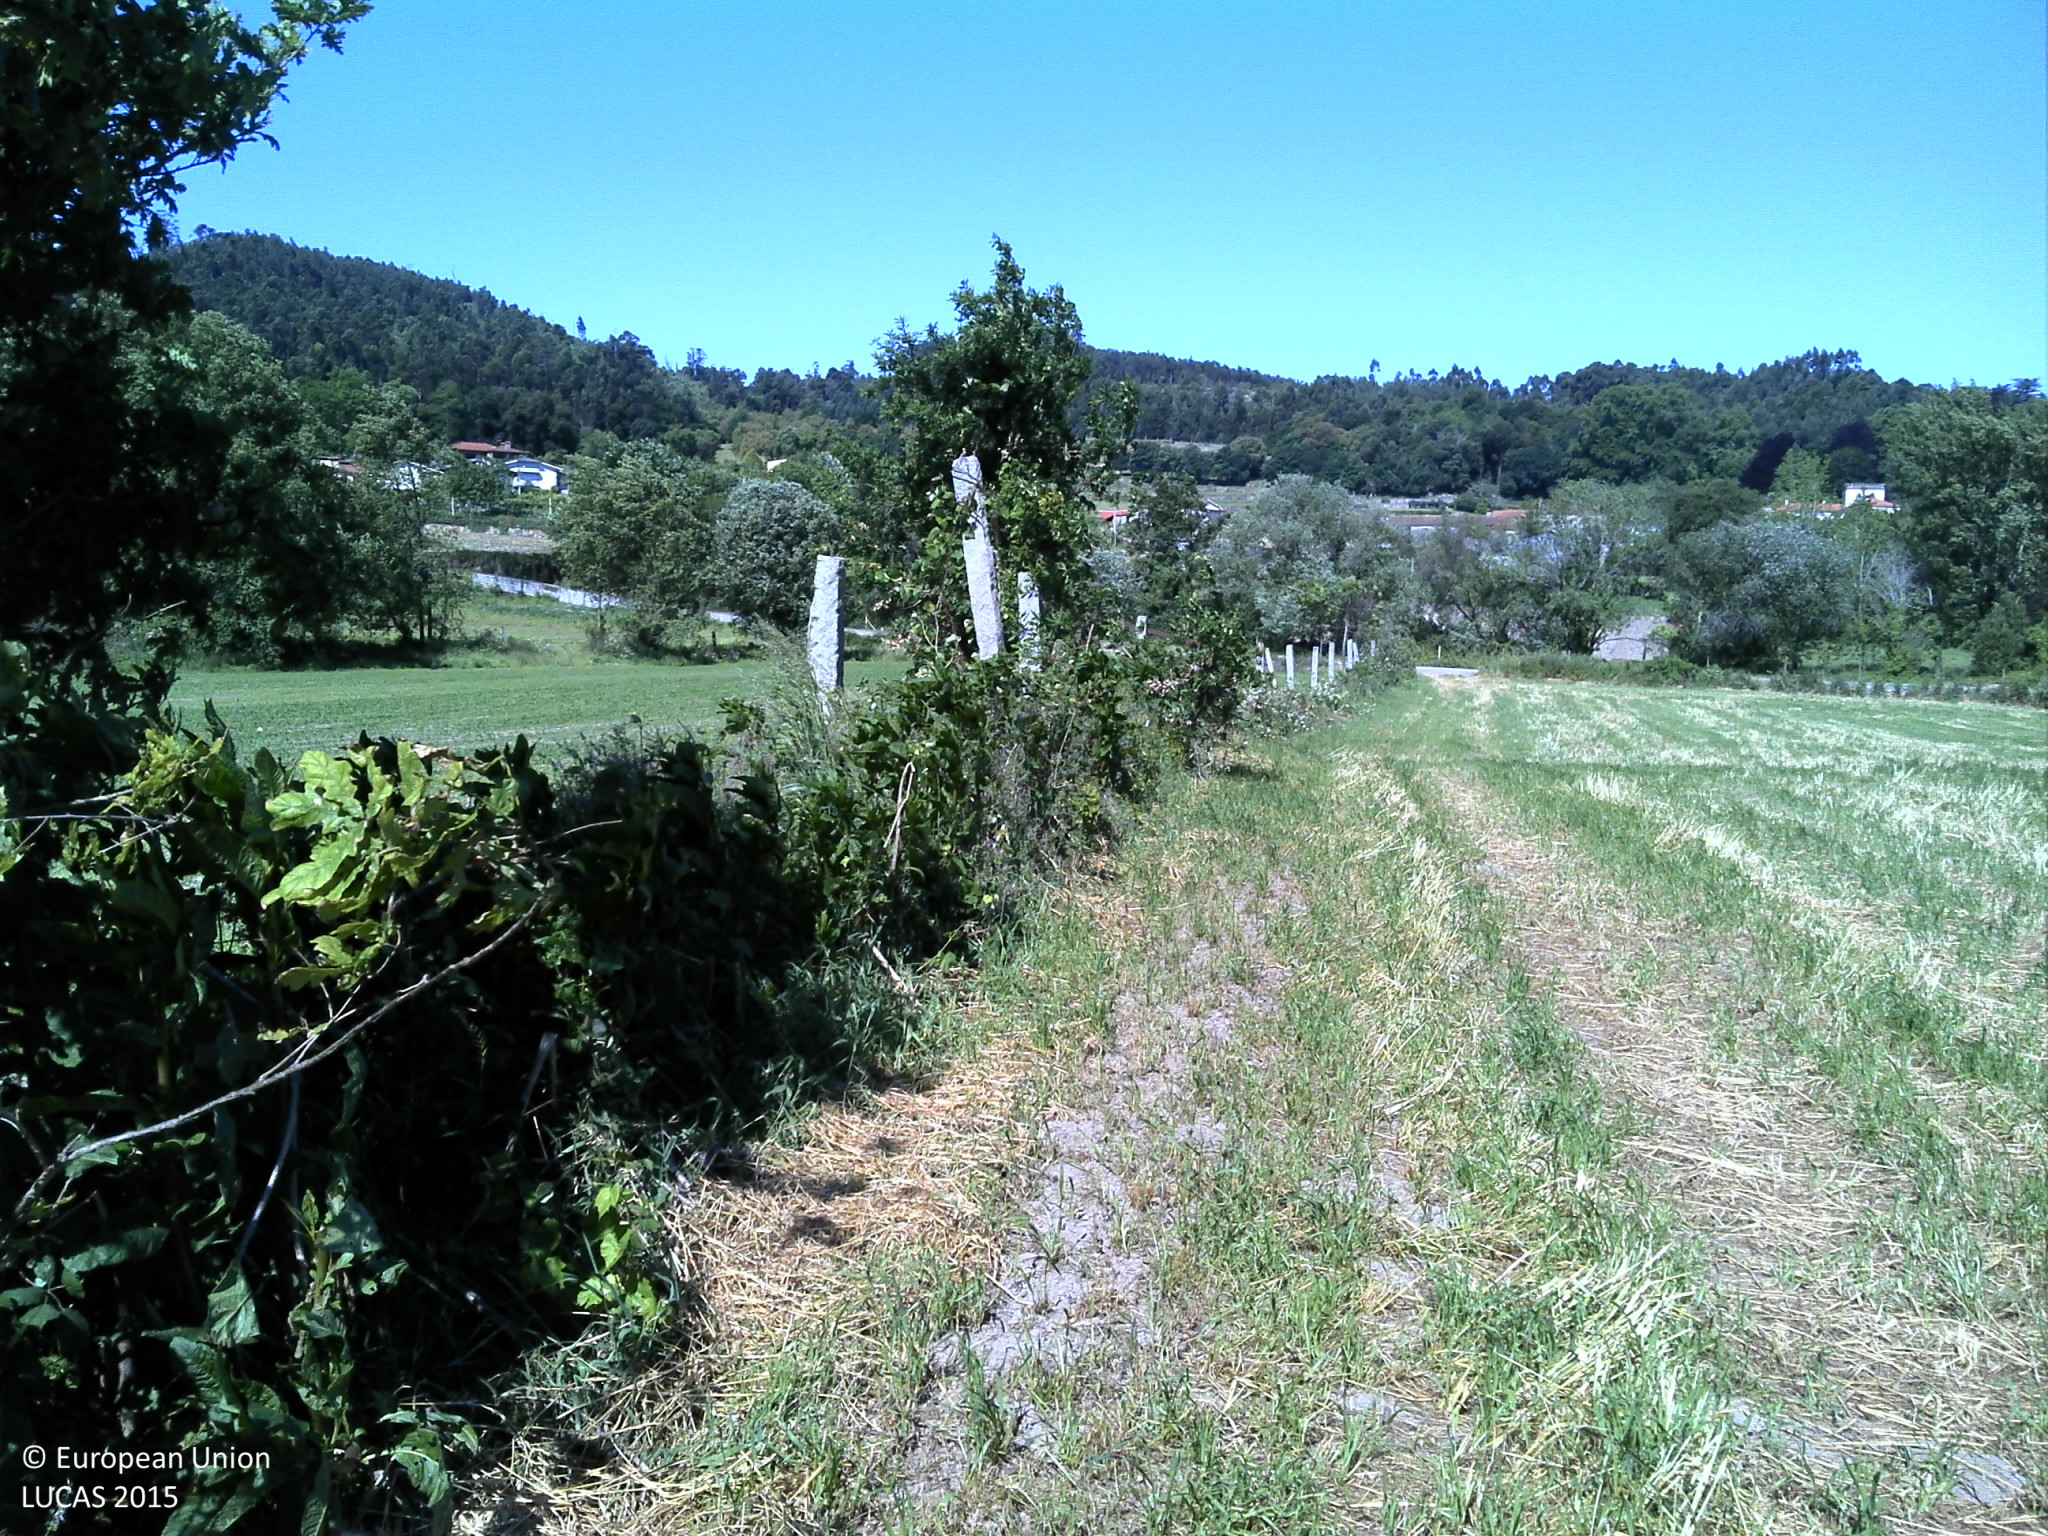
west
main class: Cropland
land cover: Temporary grasslands
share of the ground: 25 - 50 %
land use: Agriculture (excluding fallow land and kitchen gardens)
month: May
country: PT
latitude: 41.3000
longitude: -8.6067
